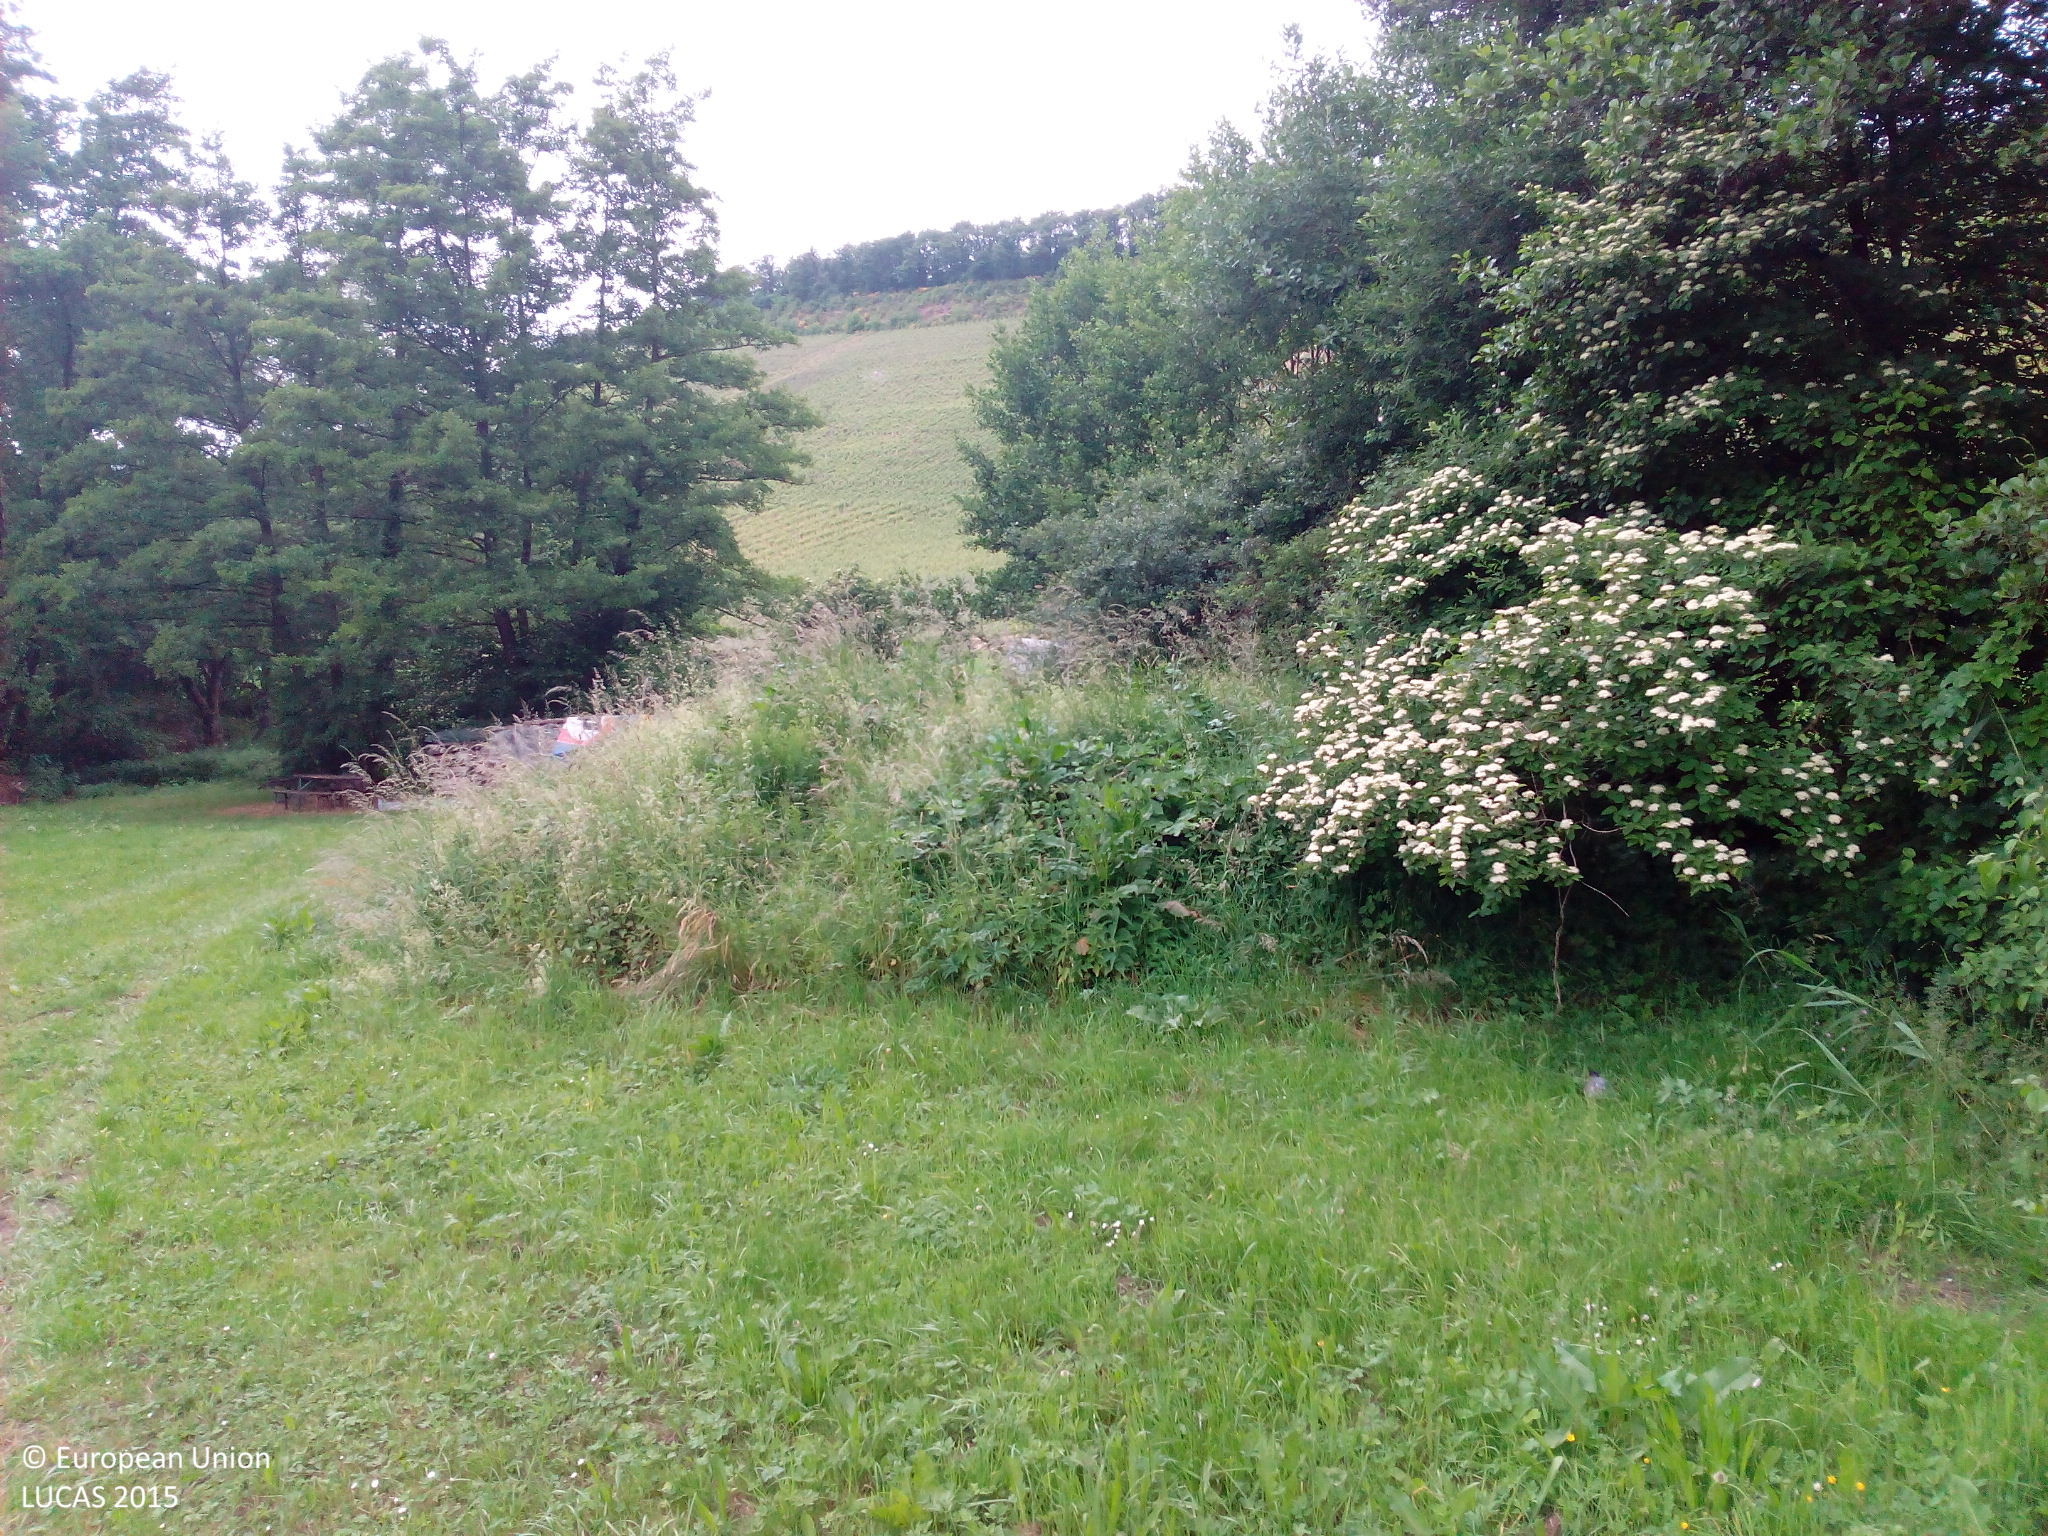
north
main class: Grassland
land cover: Grassland without tree/shrub cover
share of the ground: > 75 %
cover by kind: herbaceous plants 100 %
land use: Agriculture (excluding fallow land and kitchen gardens)
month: June
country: DE
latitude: 49.1216
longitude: 9.4111
